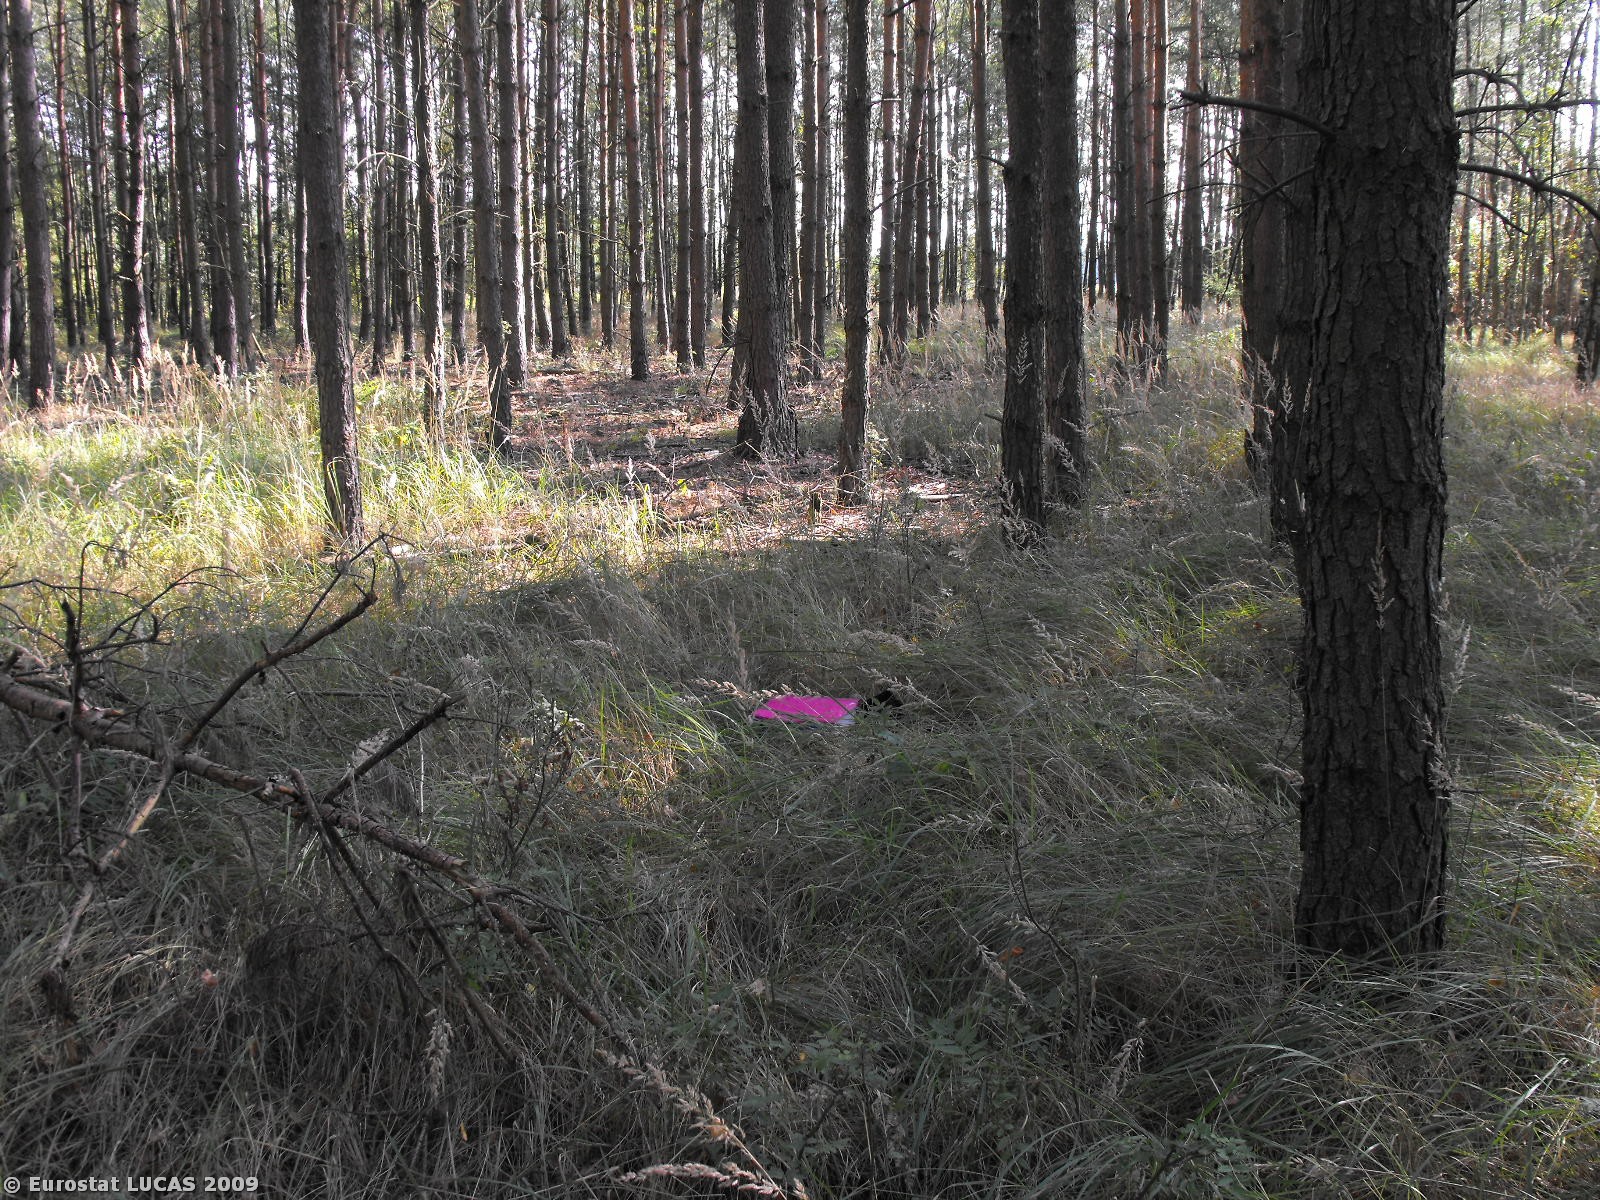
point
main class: Woodland
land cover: Coniferous woodland
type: hemiboreal forest and nemoral coniferous forest and mixed broadleaved-coniferous forest
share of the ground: > 75 %
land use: Forestry
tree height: > 5 m
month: September
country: PL
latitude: 52.3362
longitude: 16.3028
